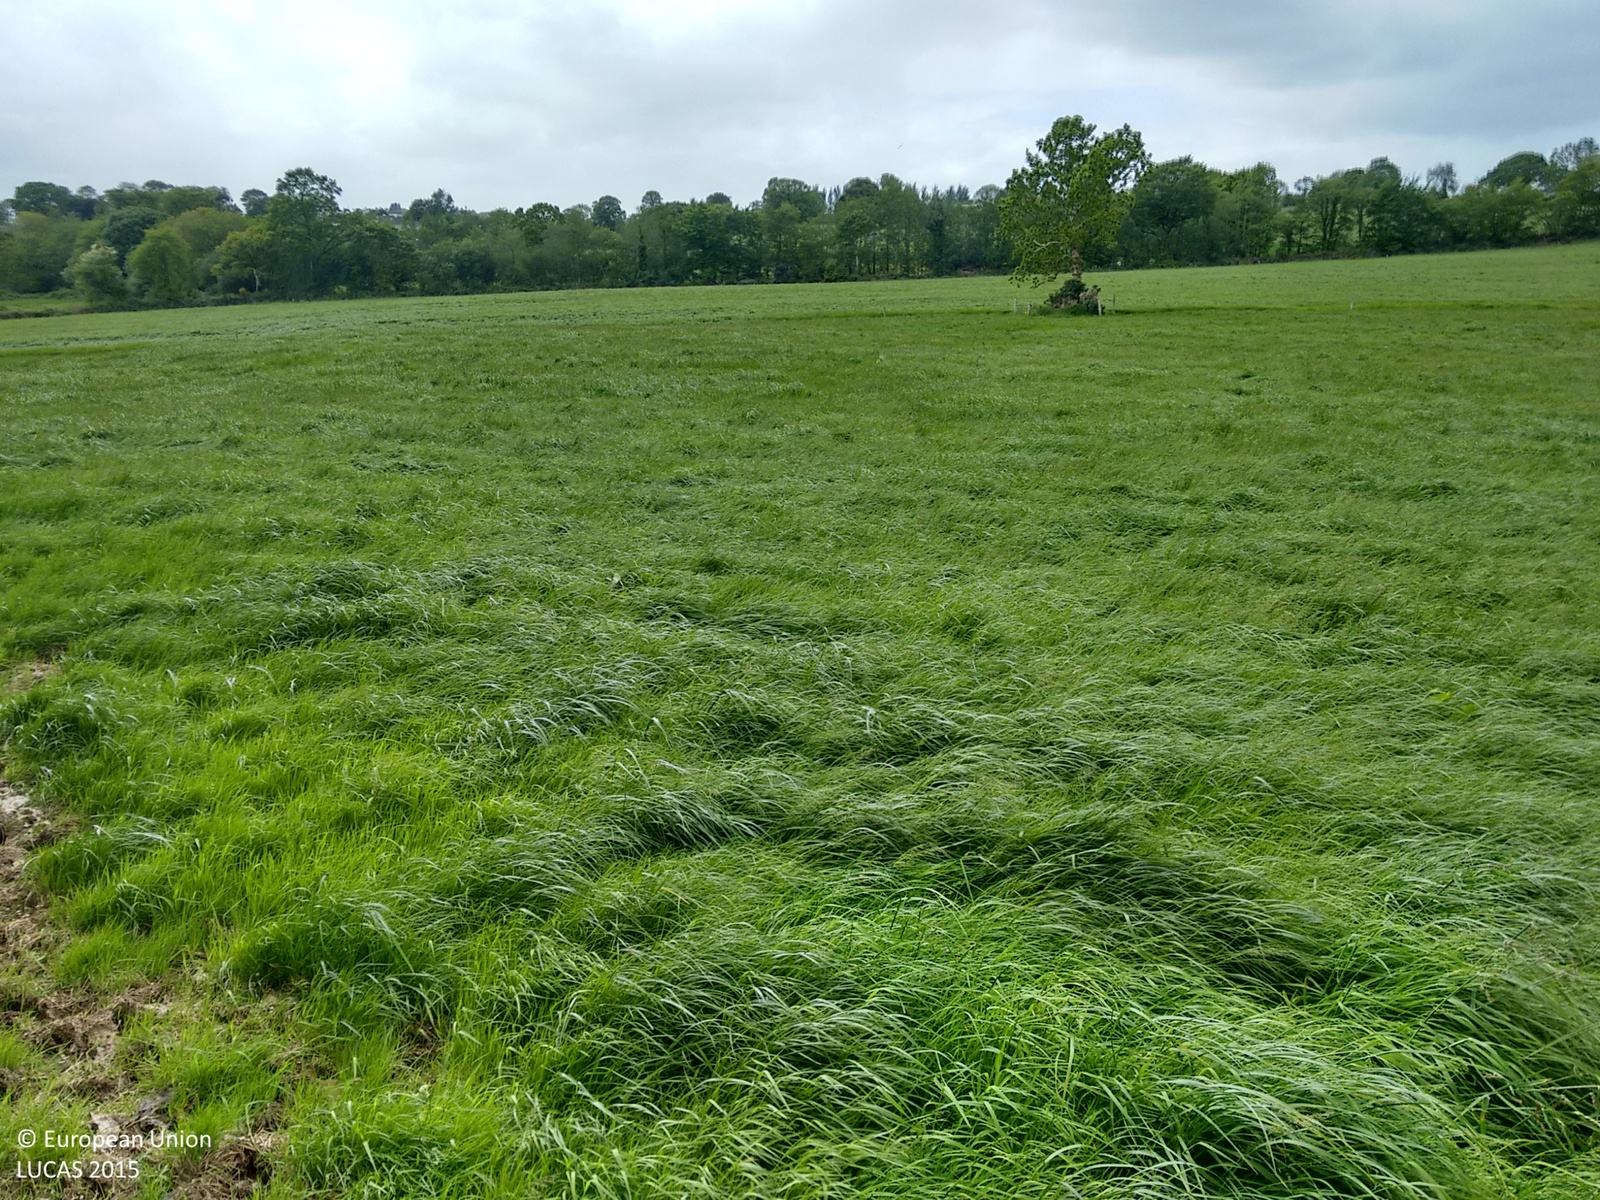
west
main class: Grassland
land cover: Grassland without tree/shrub cover
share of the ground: > 75 %
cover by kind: herbaceous plants 100 %
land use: Agriculture (excluding fallow land and kitchen gardens)
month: June
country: IE
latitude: 51.9093
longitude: -8.7972
